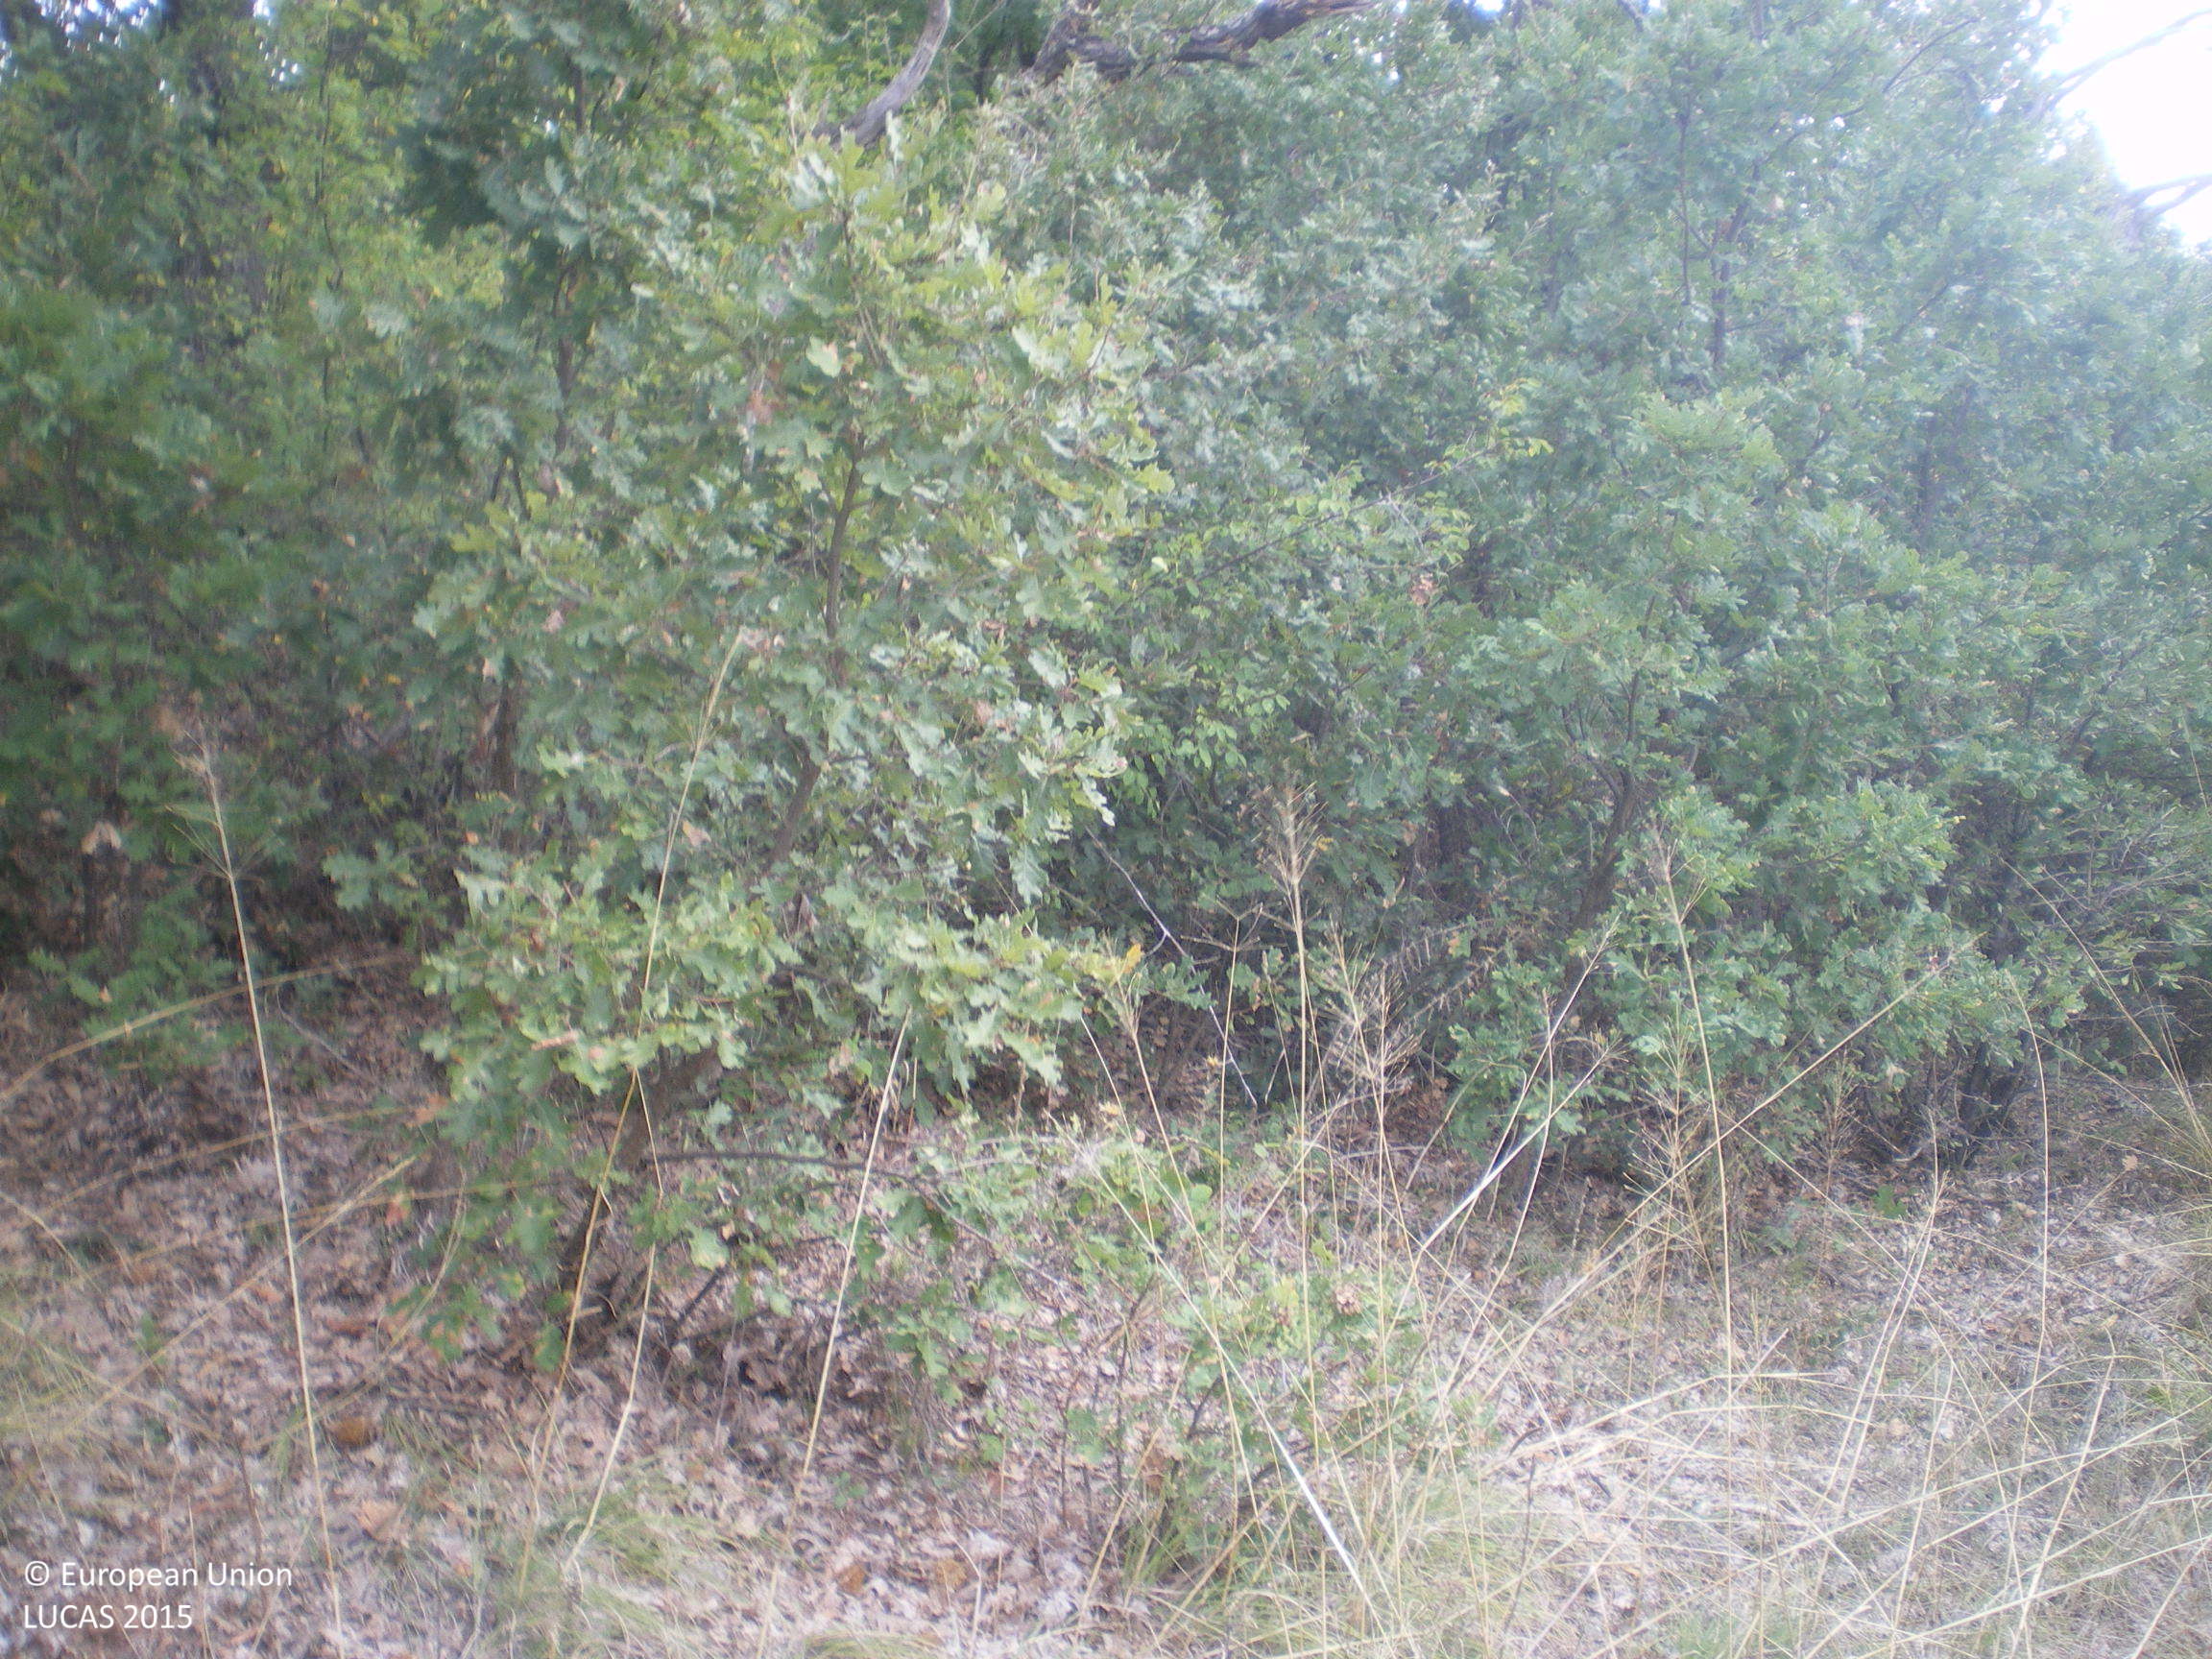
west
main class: Woodland
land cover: Broadleaved woodland
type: mesophytic deciduous forest
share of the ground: > 75 %
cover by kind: broadleaved forest trees 75 %, herbaceous plants 15 %, shrubs 10 %
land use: Forestry
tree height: > 5 m
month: October
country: BG
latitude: 41.9631
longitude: 26.2106
